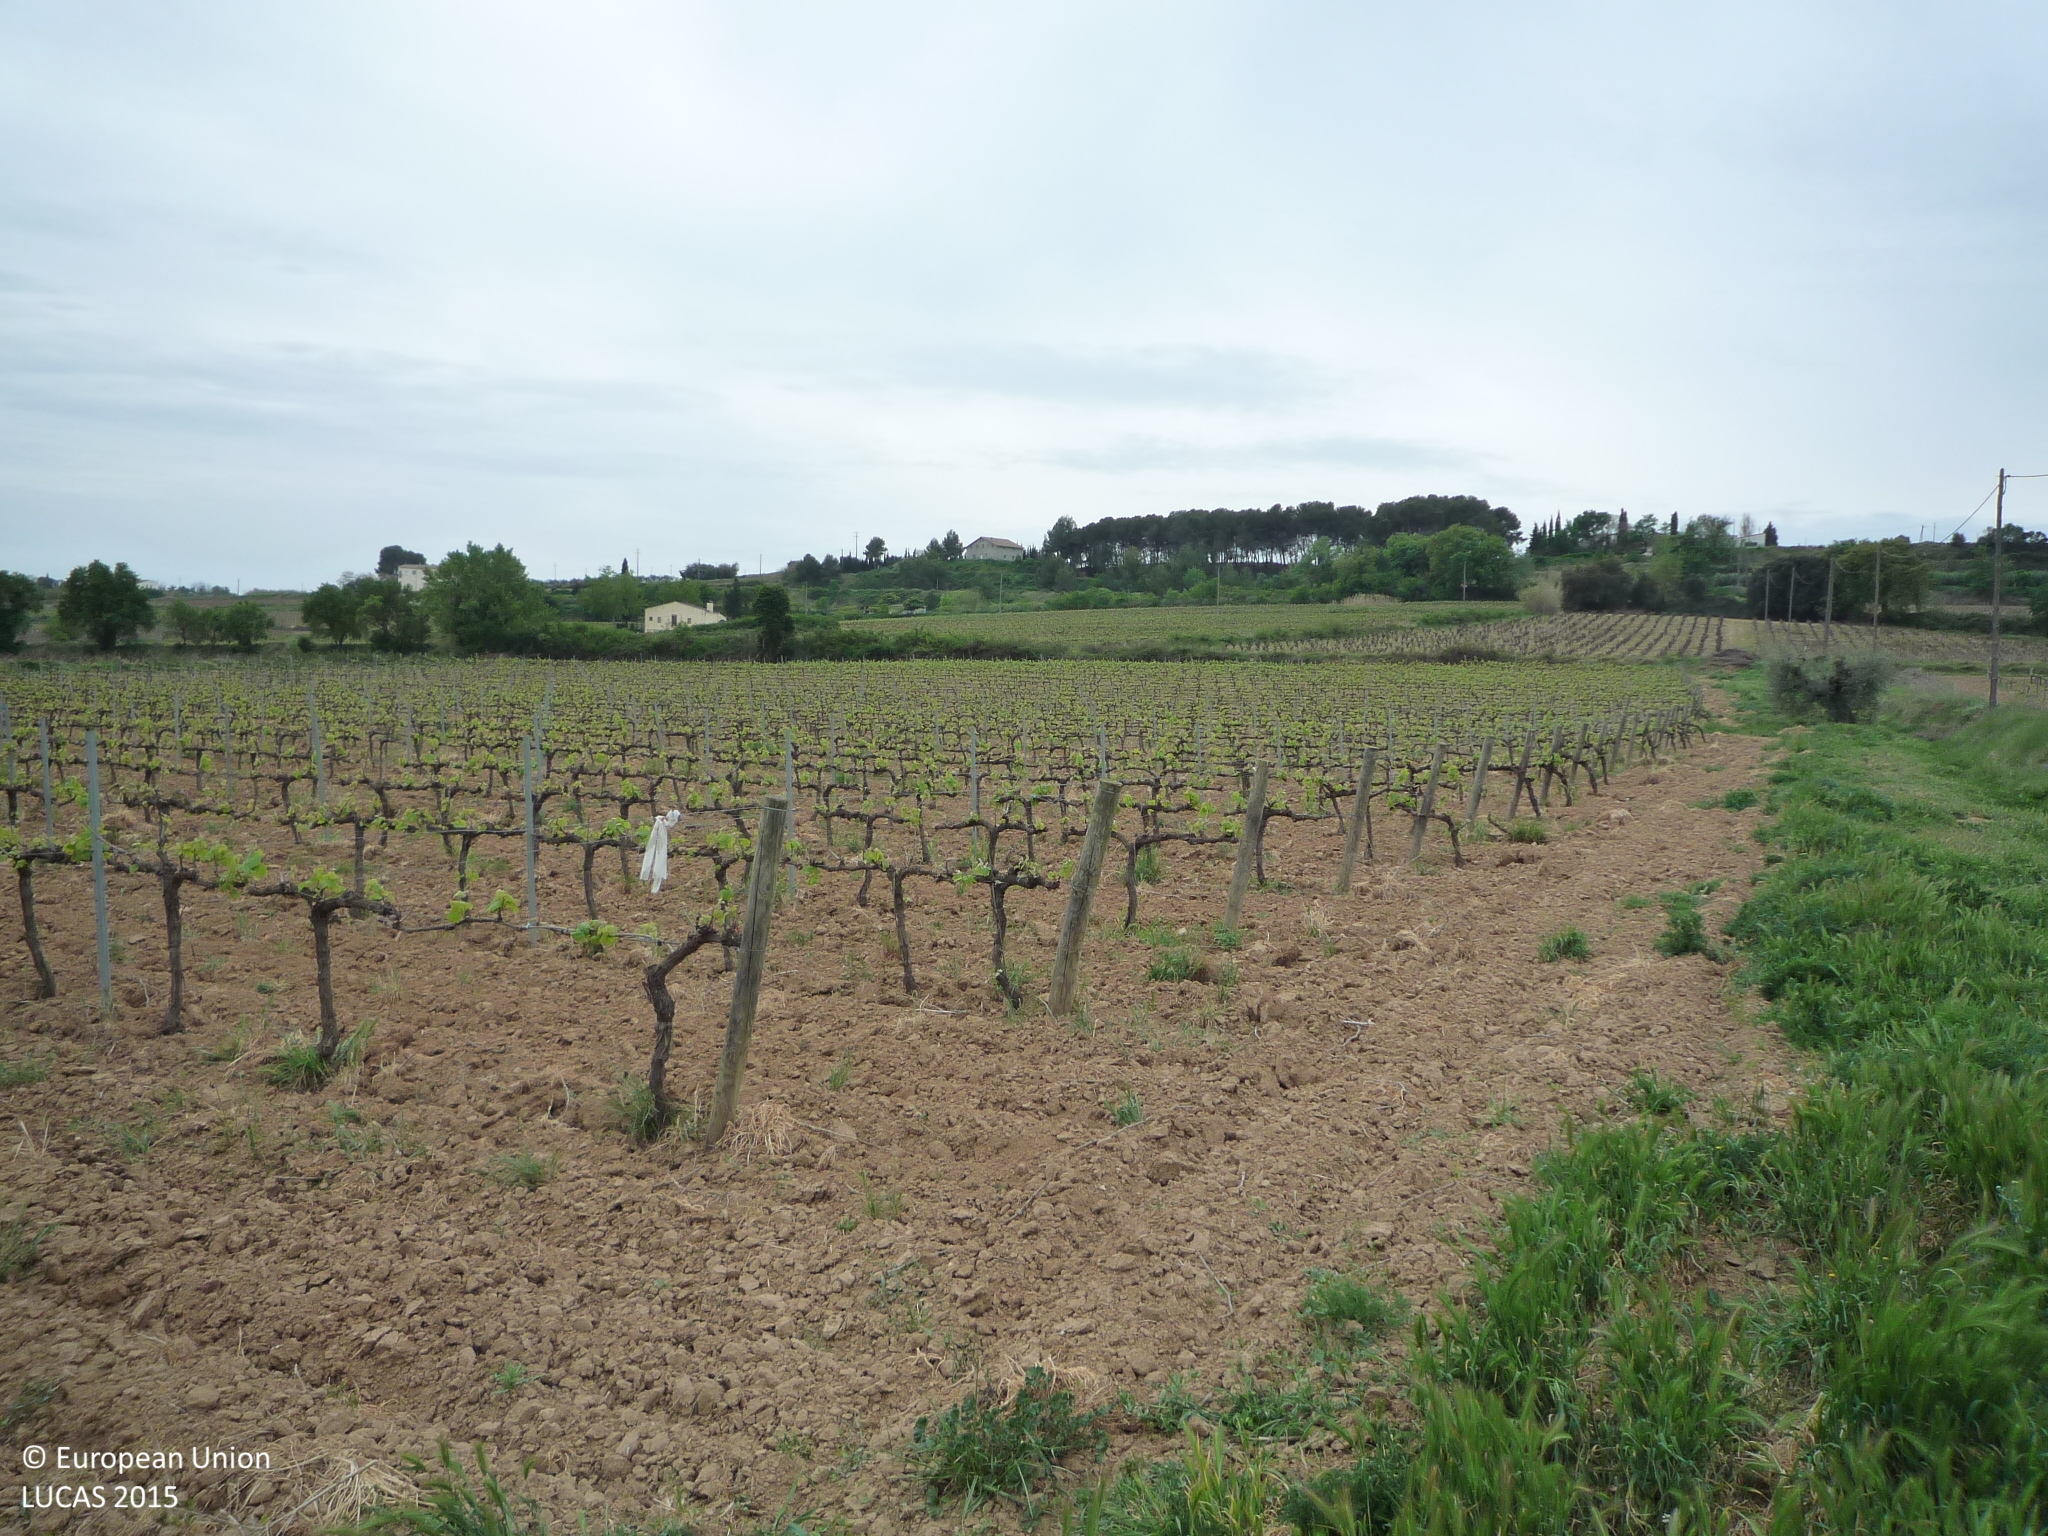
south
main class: Cropland
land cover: Vineyards
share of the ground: > 75 %
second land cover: Other bare soil
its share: > 75 %
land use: Agriculture (excluding fallow land and kitchen gardens)
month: April
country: ES
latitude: 41.4035
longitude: 1.6796
